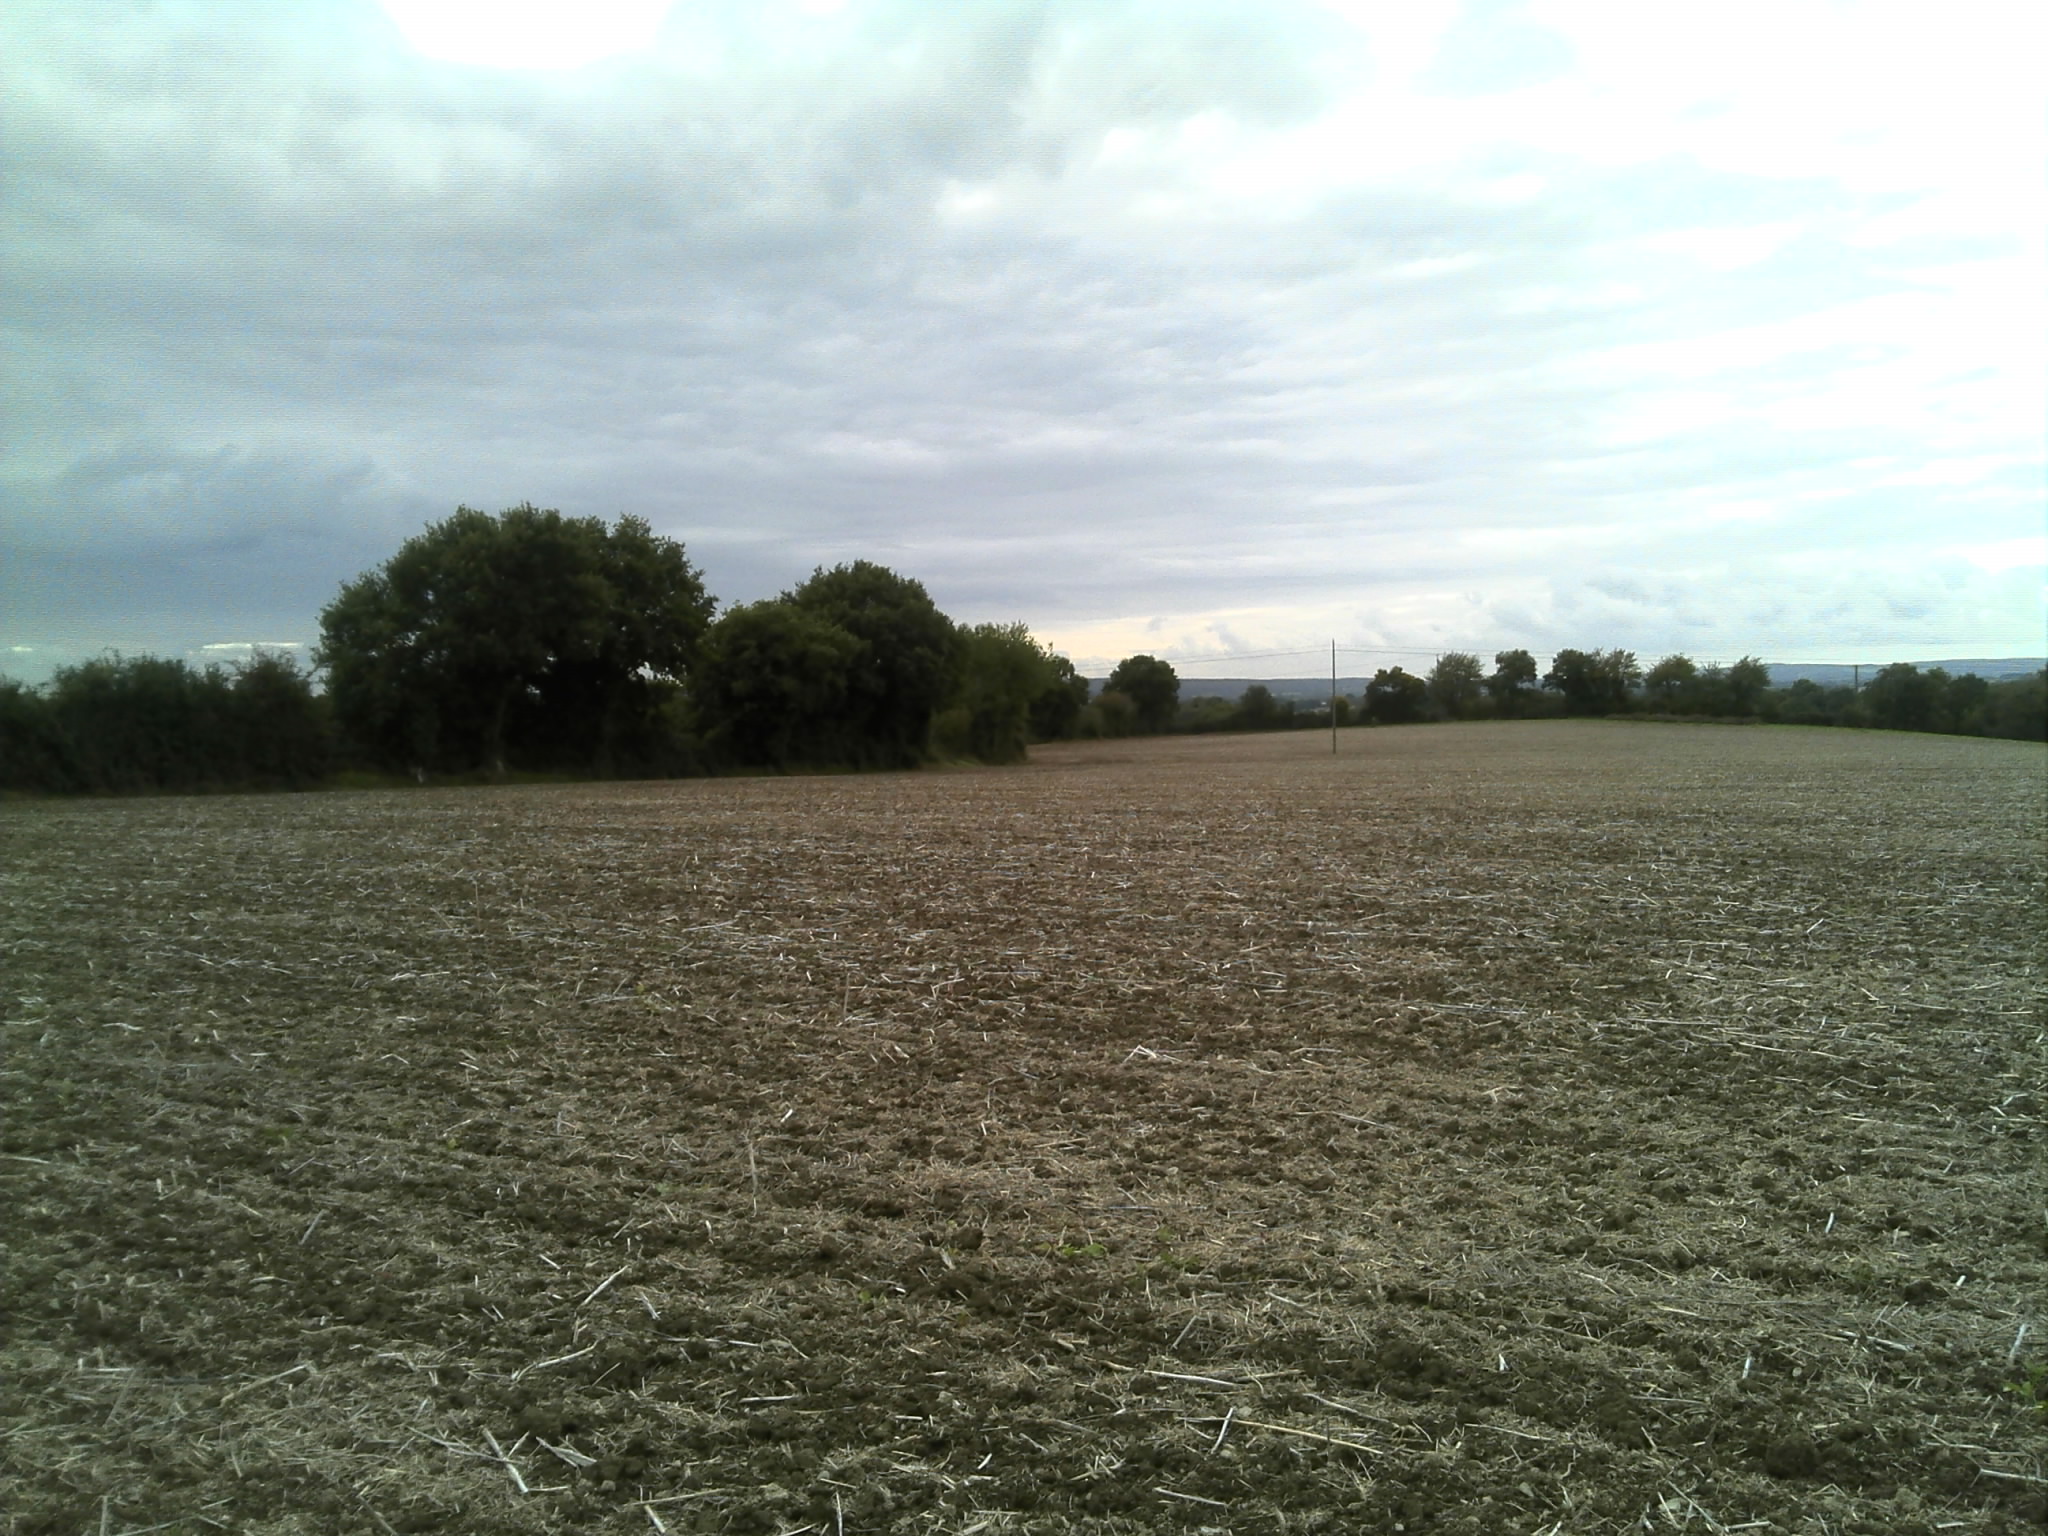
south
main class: Cropland
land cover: Rape and turnip rape
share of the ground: < 10 %
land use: Agriculture (excluding fallow land and kitchen gardens)
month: October
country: FR
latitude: 48.1551
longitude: -0.1253
